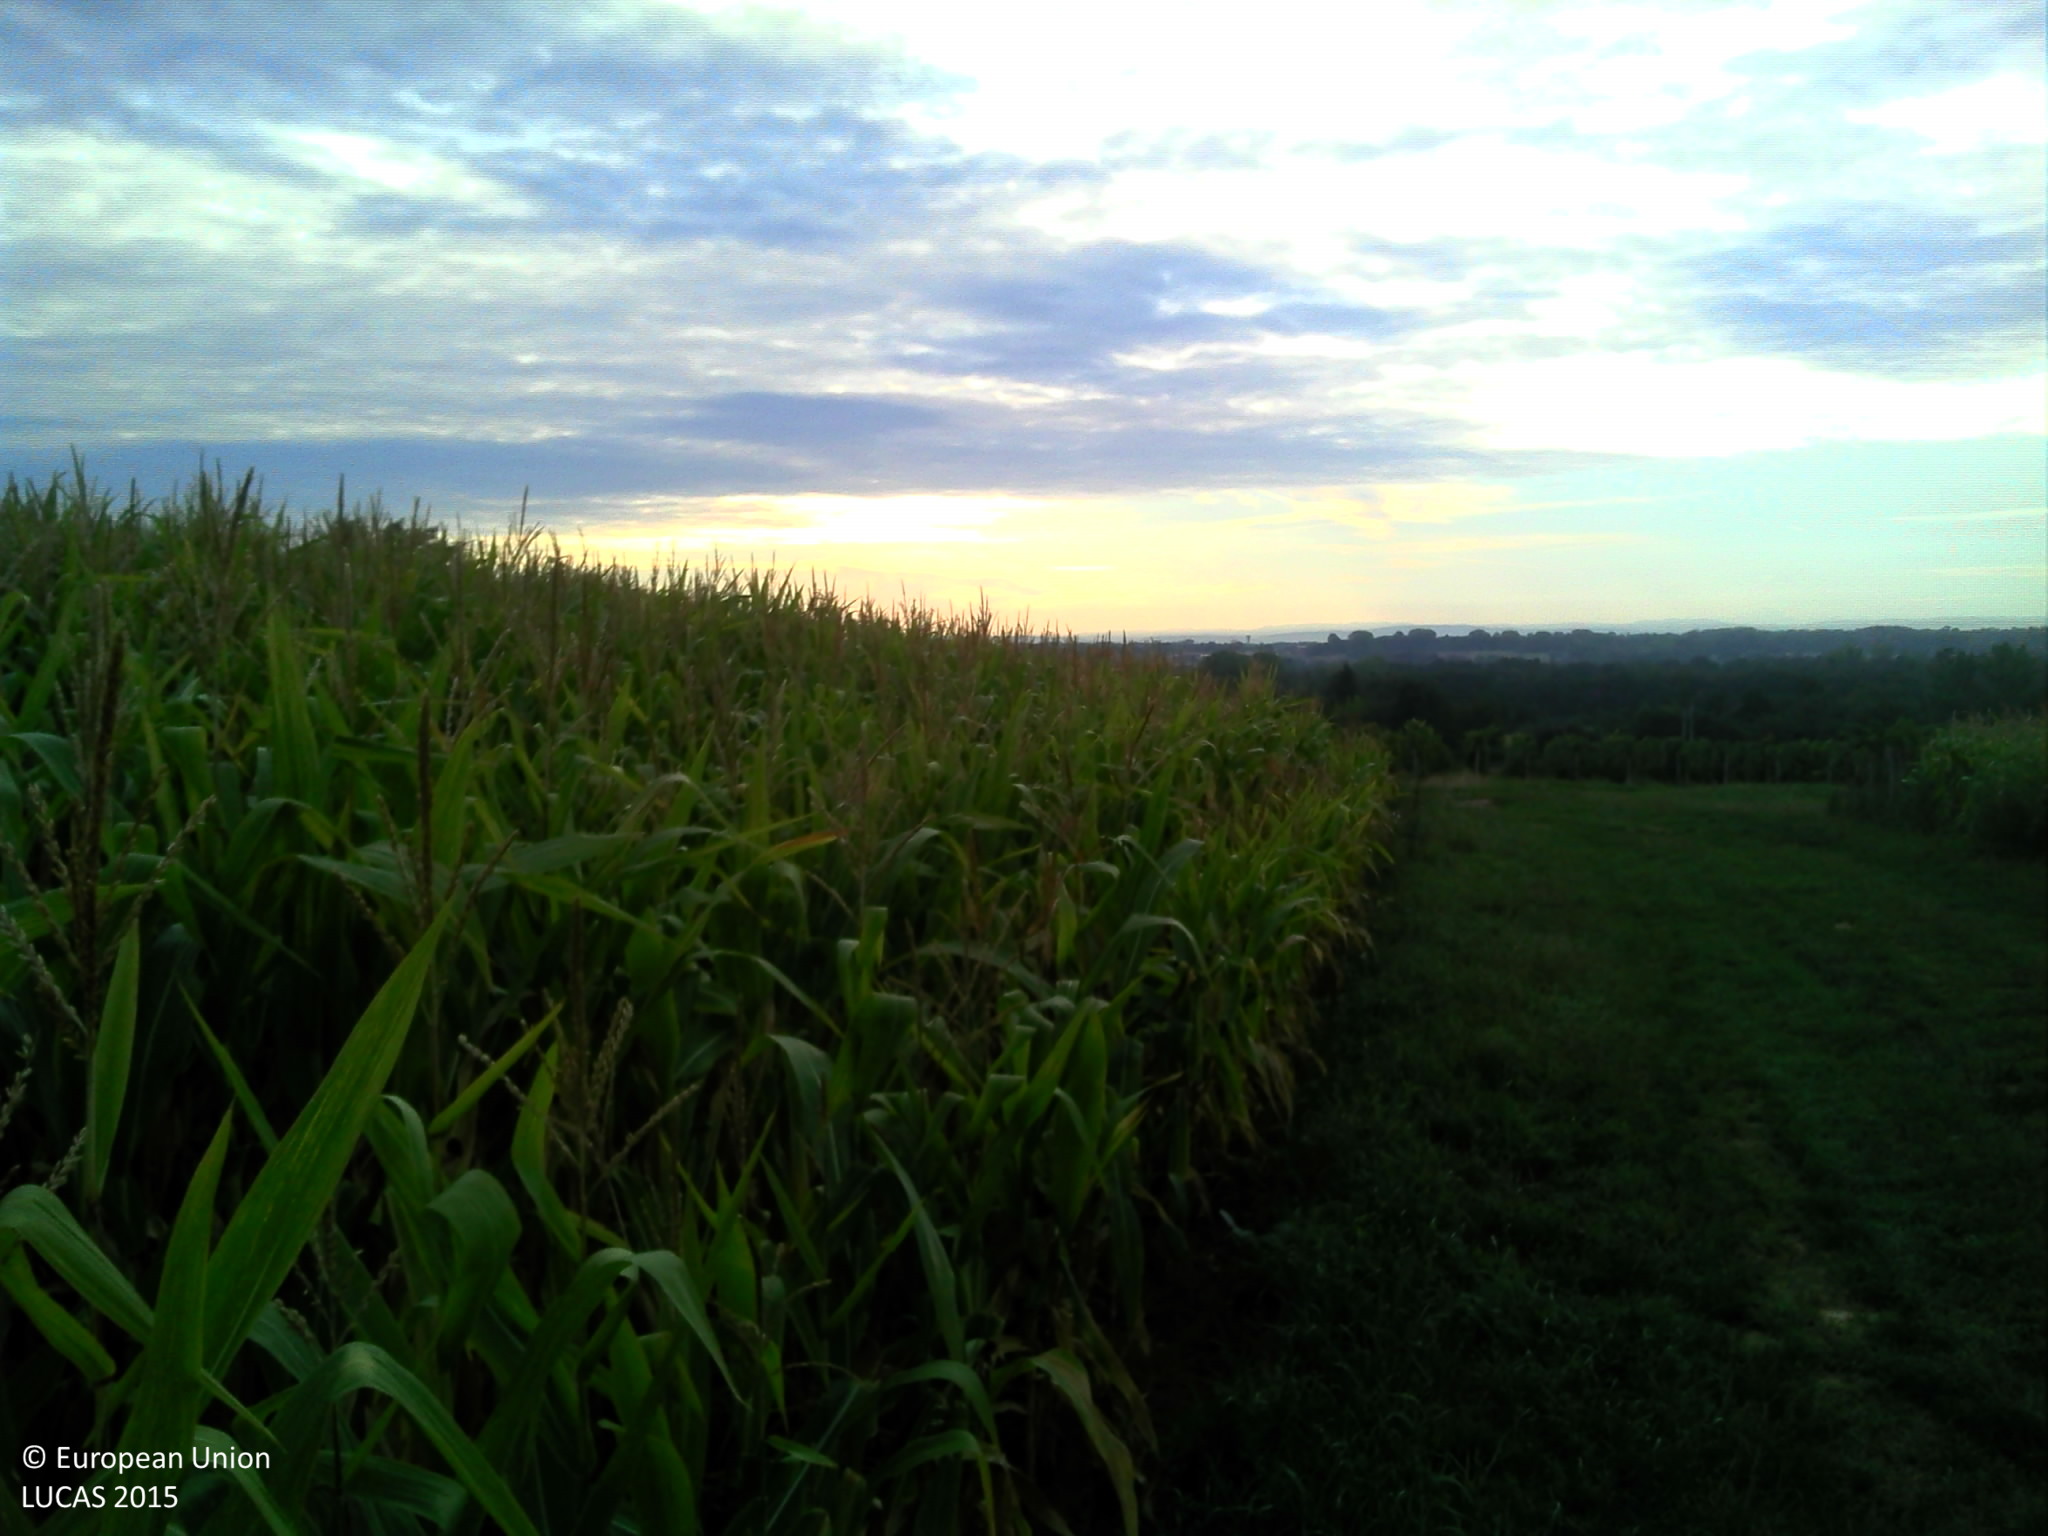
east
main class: Cropland
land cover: Maize
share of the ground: > 75 %
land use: Agriculture (excluding fallow land and kitchen gardens)
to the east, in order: Maize; Grass margins; Tracks; Grassland without tree/shrub cover; Vineyards; Grassland without tree/shrub cover; Abandoned hedges; Fences; Grassland without tree/shrub cover
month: August
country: FR
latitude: 46.3903
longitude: 4.8655
